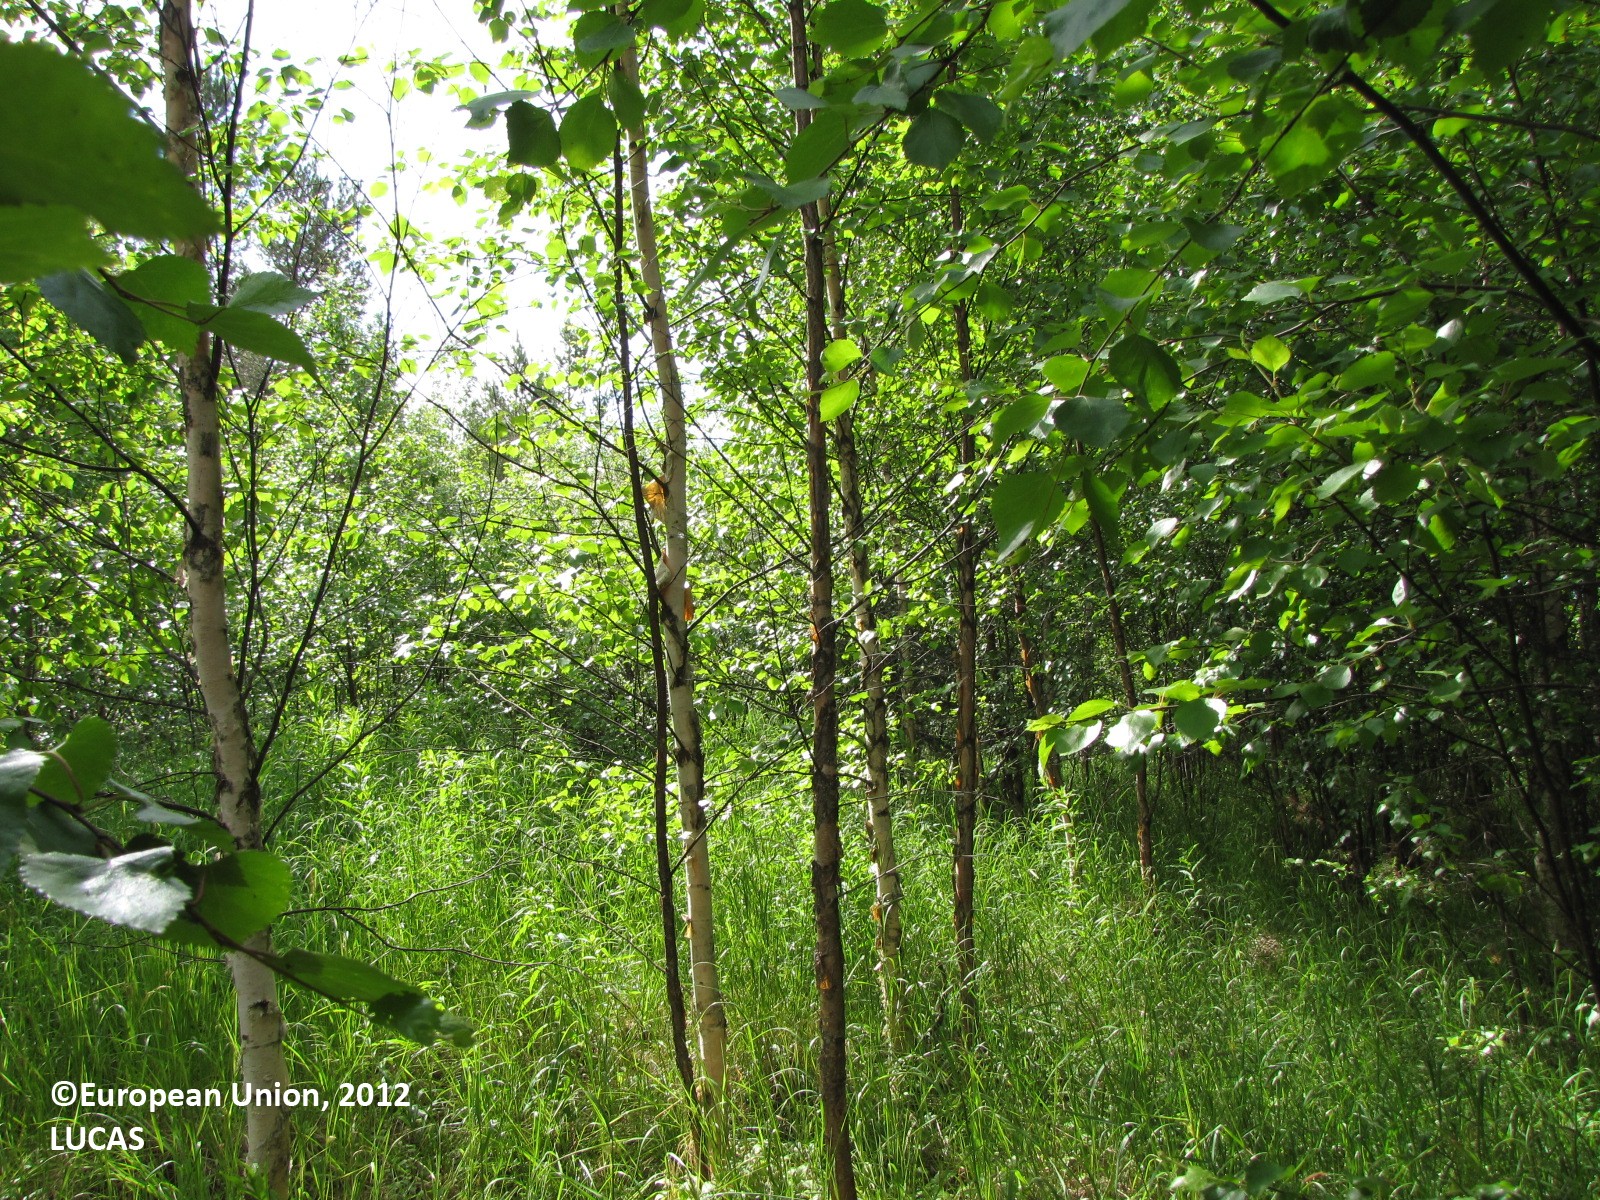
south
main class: Woodland
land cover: Broadleaved woodland
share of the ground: 50 - 75 %
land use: Forestry
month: July
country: FI
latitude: 66.1420
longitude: 25.1502
